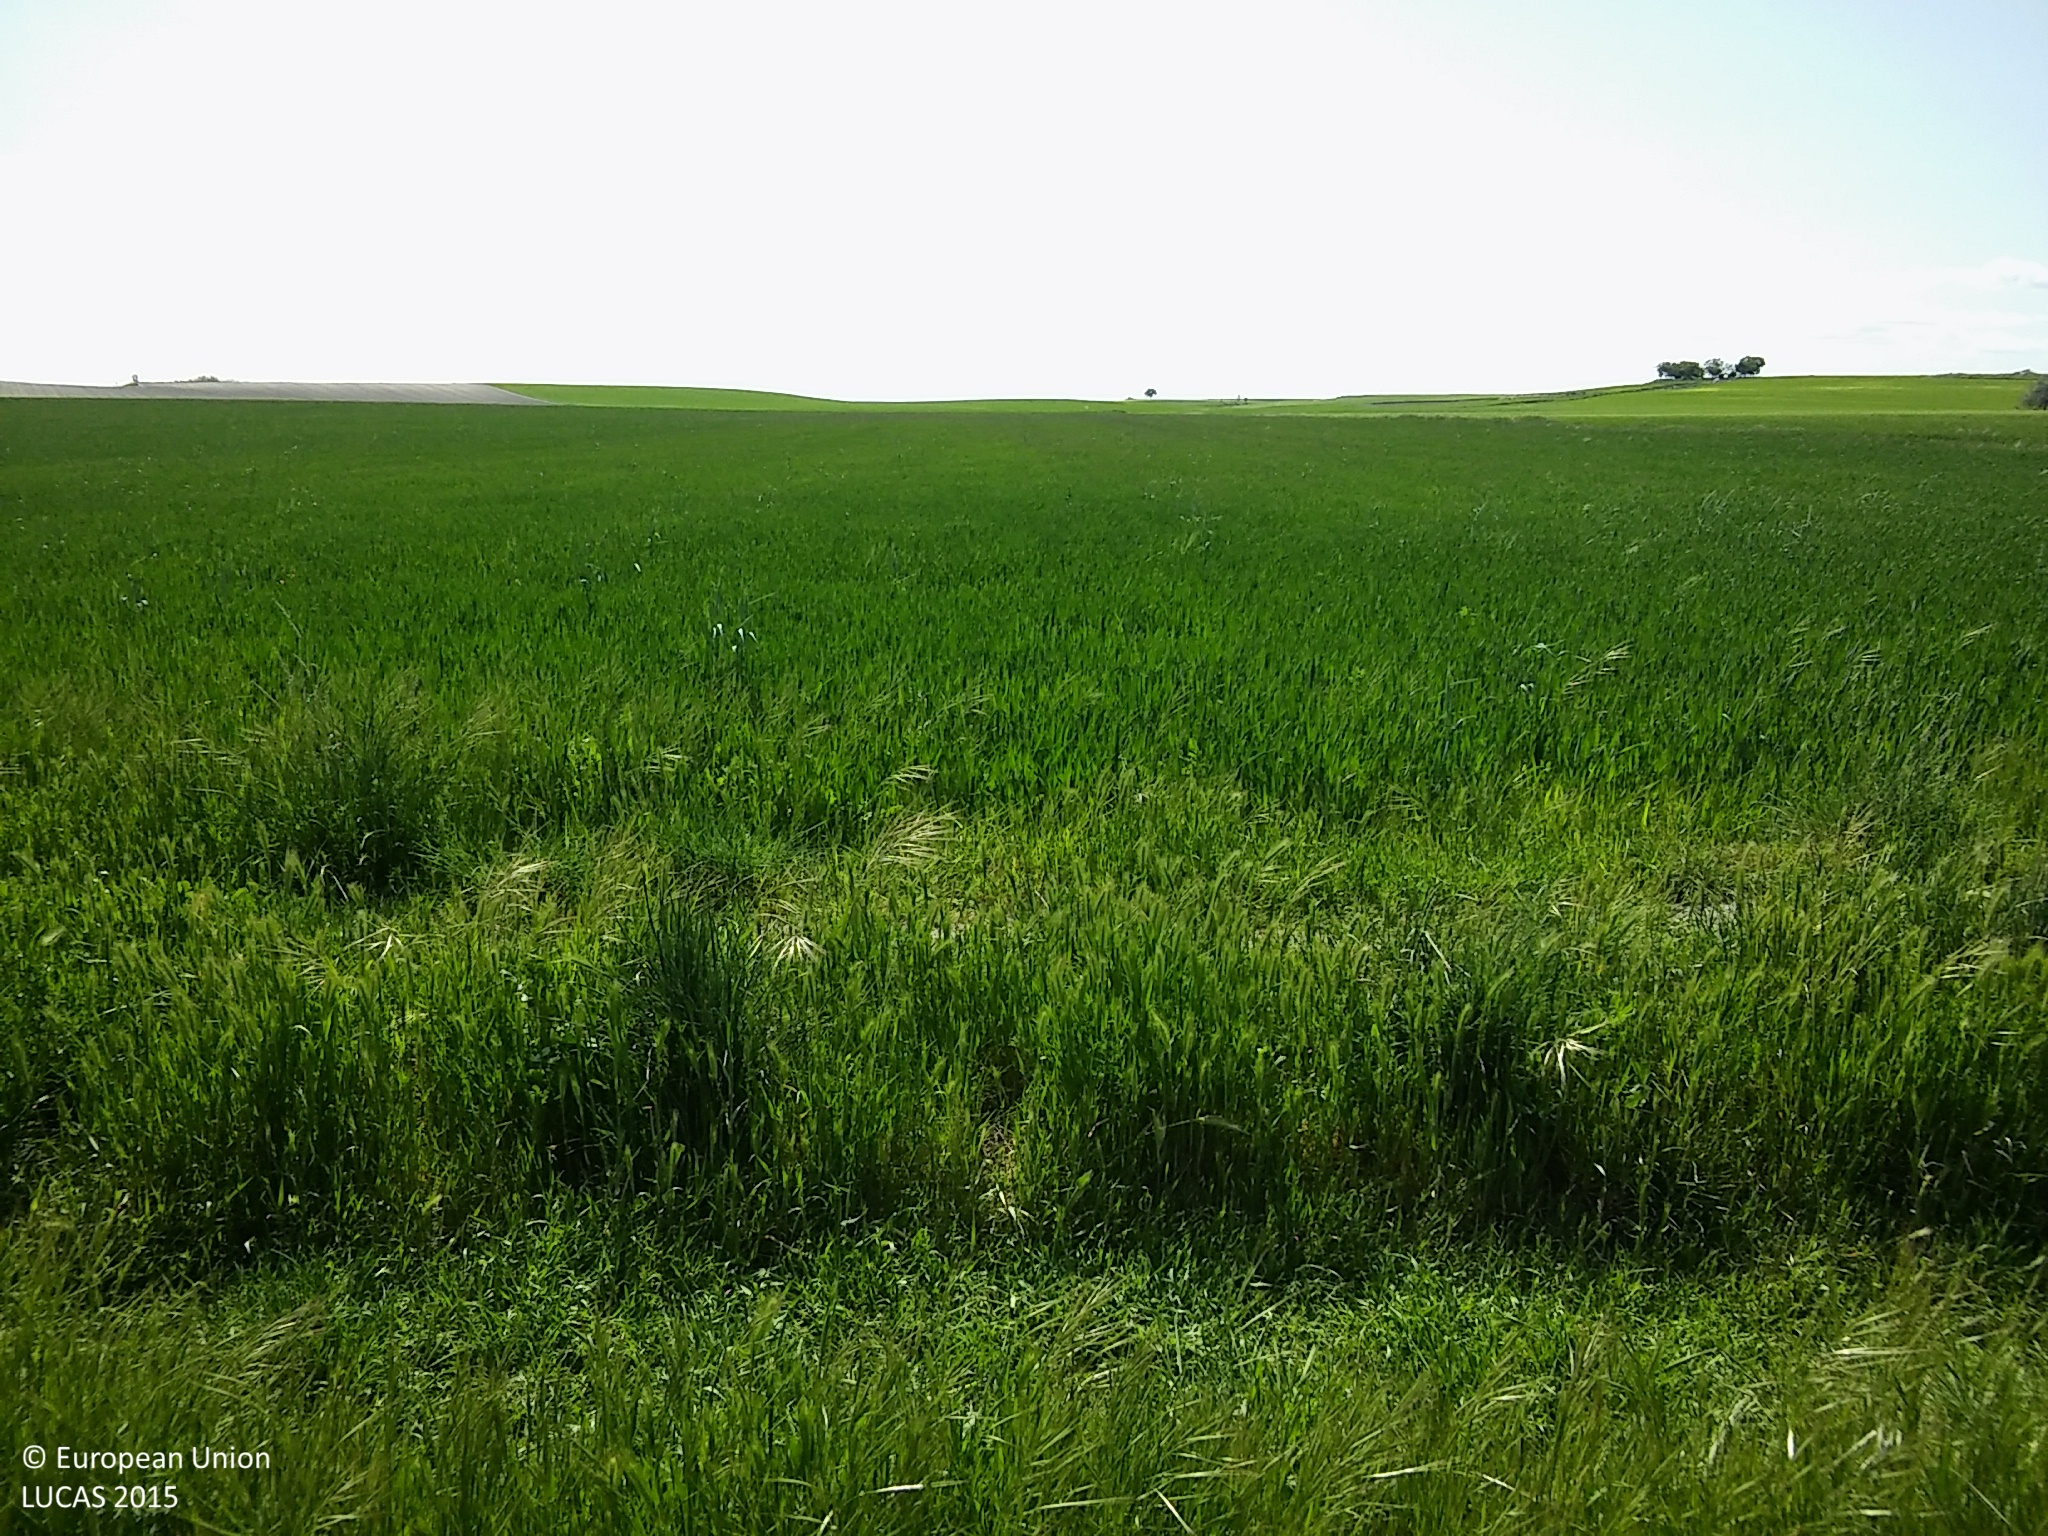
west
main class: Cropland
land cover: Barley
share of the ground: > 75 %
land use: Agriculture (excluding fallow land and kitchen gardens)
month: May
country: ES
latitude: 41.4008
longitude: -4.1346
